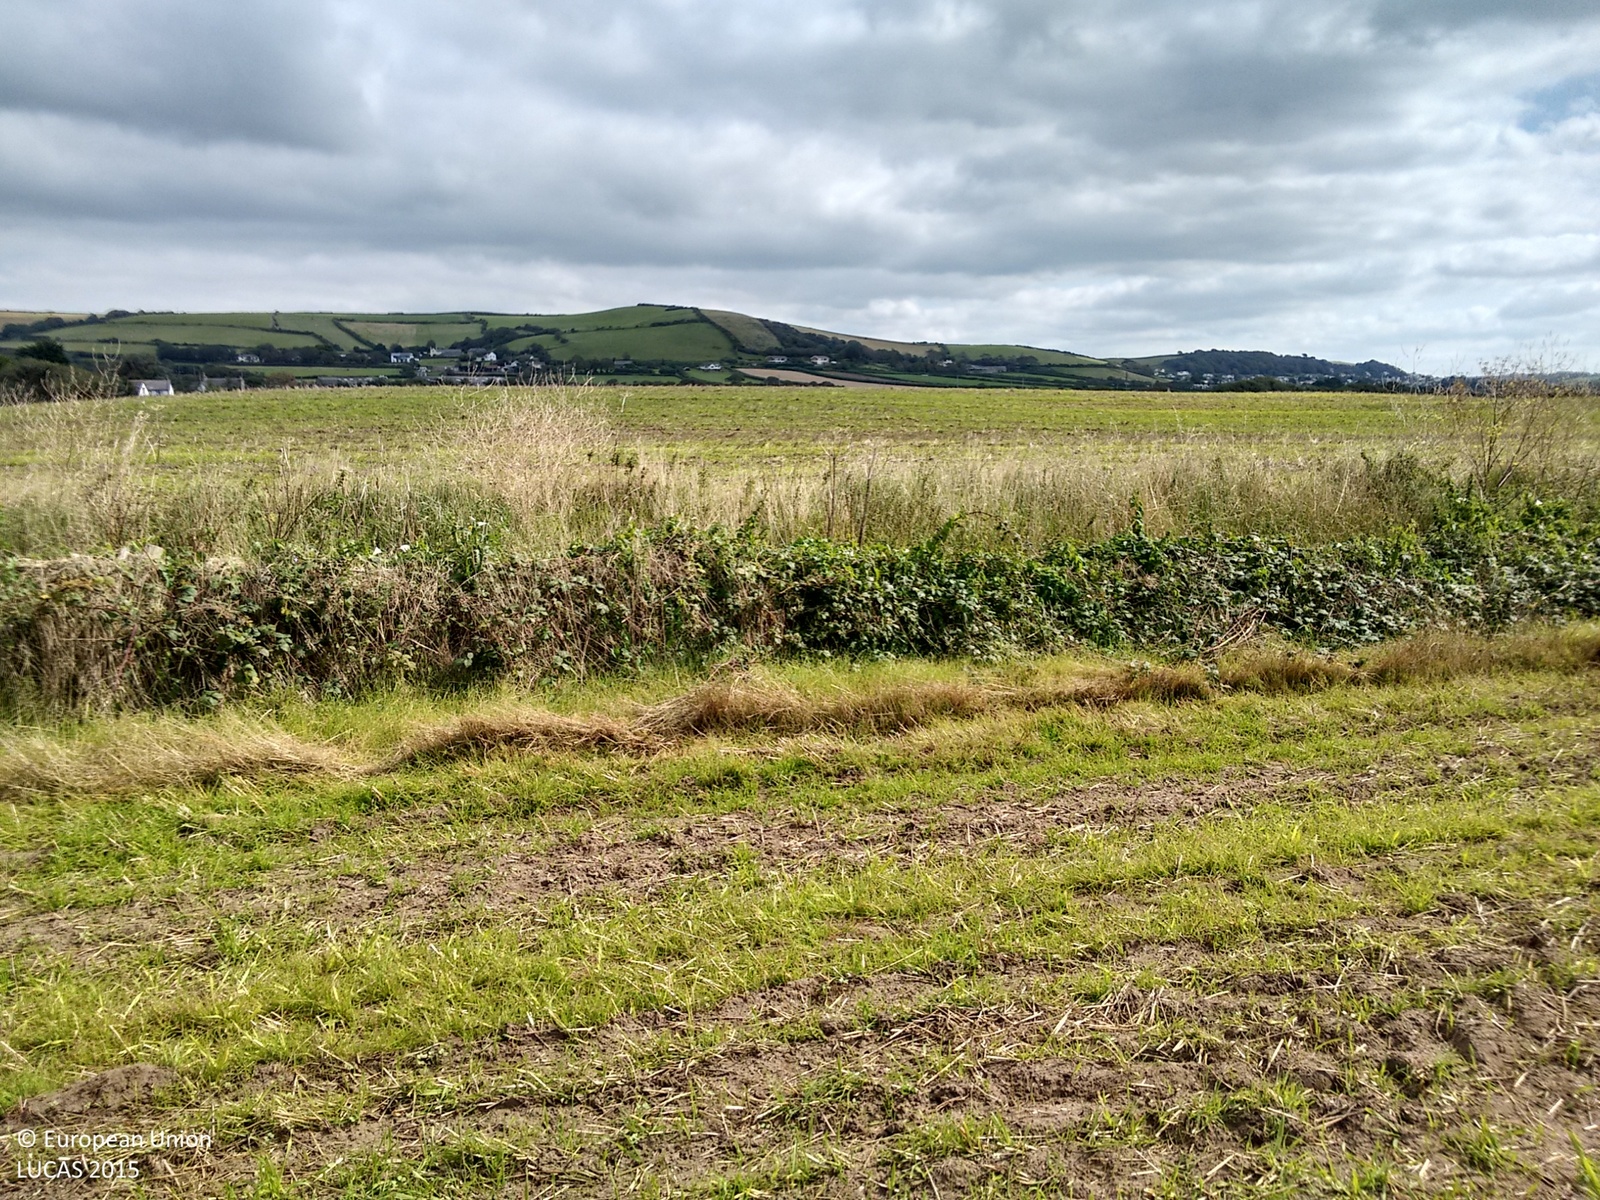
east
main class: Cropland
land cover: Barley
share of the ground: > 75 %
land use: Agriculture (excluding fallow land and kitchen gardens)
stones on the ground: < 10 %
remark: Harvested field
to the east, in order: Barley; Grass margins; Fences; Ditches and canals; Grass margins; Fences; Grass margins; Barley; Grass margins; Fences; Ditches and canals; Grass margins; Fences; Ditches and canals; Artificial constructions; Grassland without tree/shrub cover
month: September
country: GB
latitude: 51.1163
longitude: -4.1983
